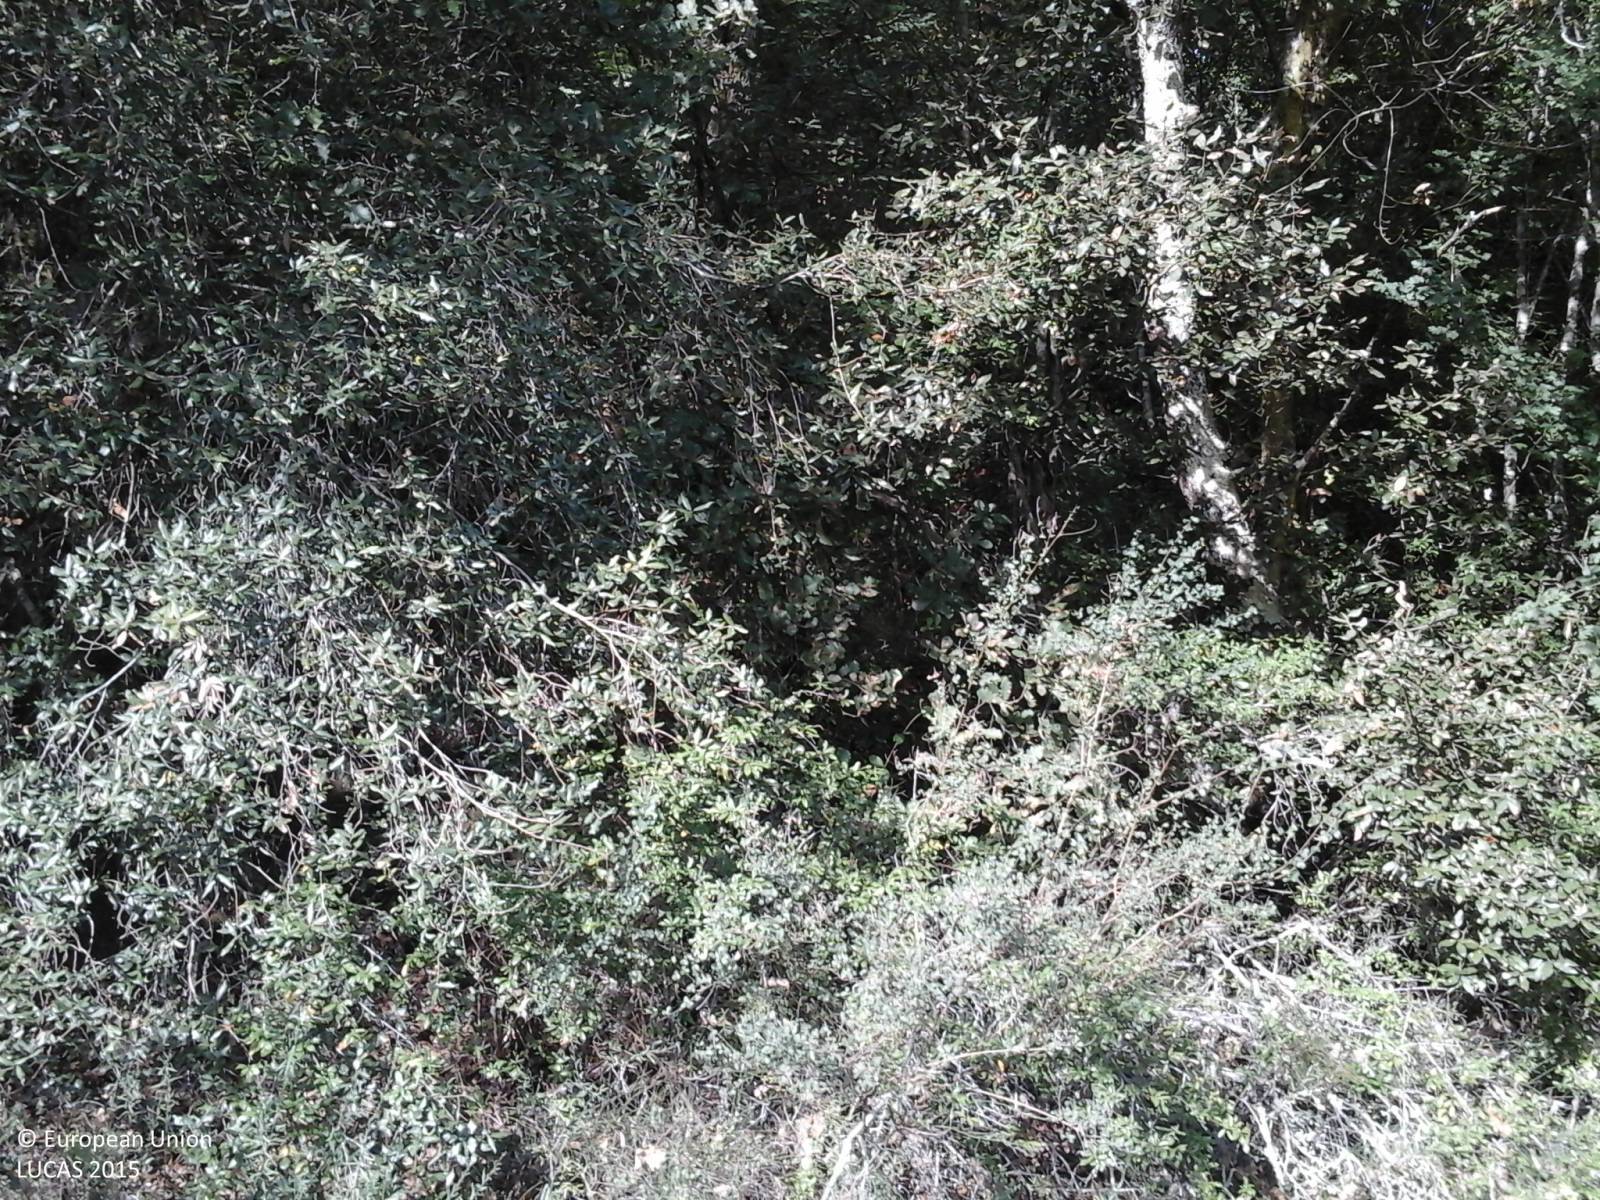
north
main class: Woodland
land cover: Broadleaved woodland
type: thermophilous deciduous forest
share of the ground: > 75 %
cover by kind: broadleaved forest trees 85 %, shrubs 15 %
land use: Forestry
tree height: > 5 m
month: September
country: IT
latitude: 42.7766
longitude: 12.1078
